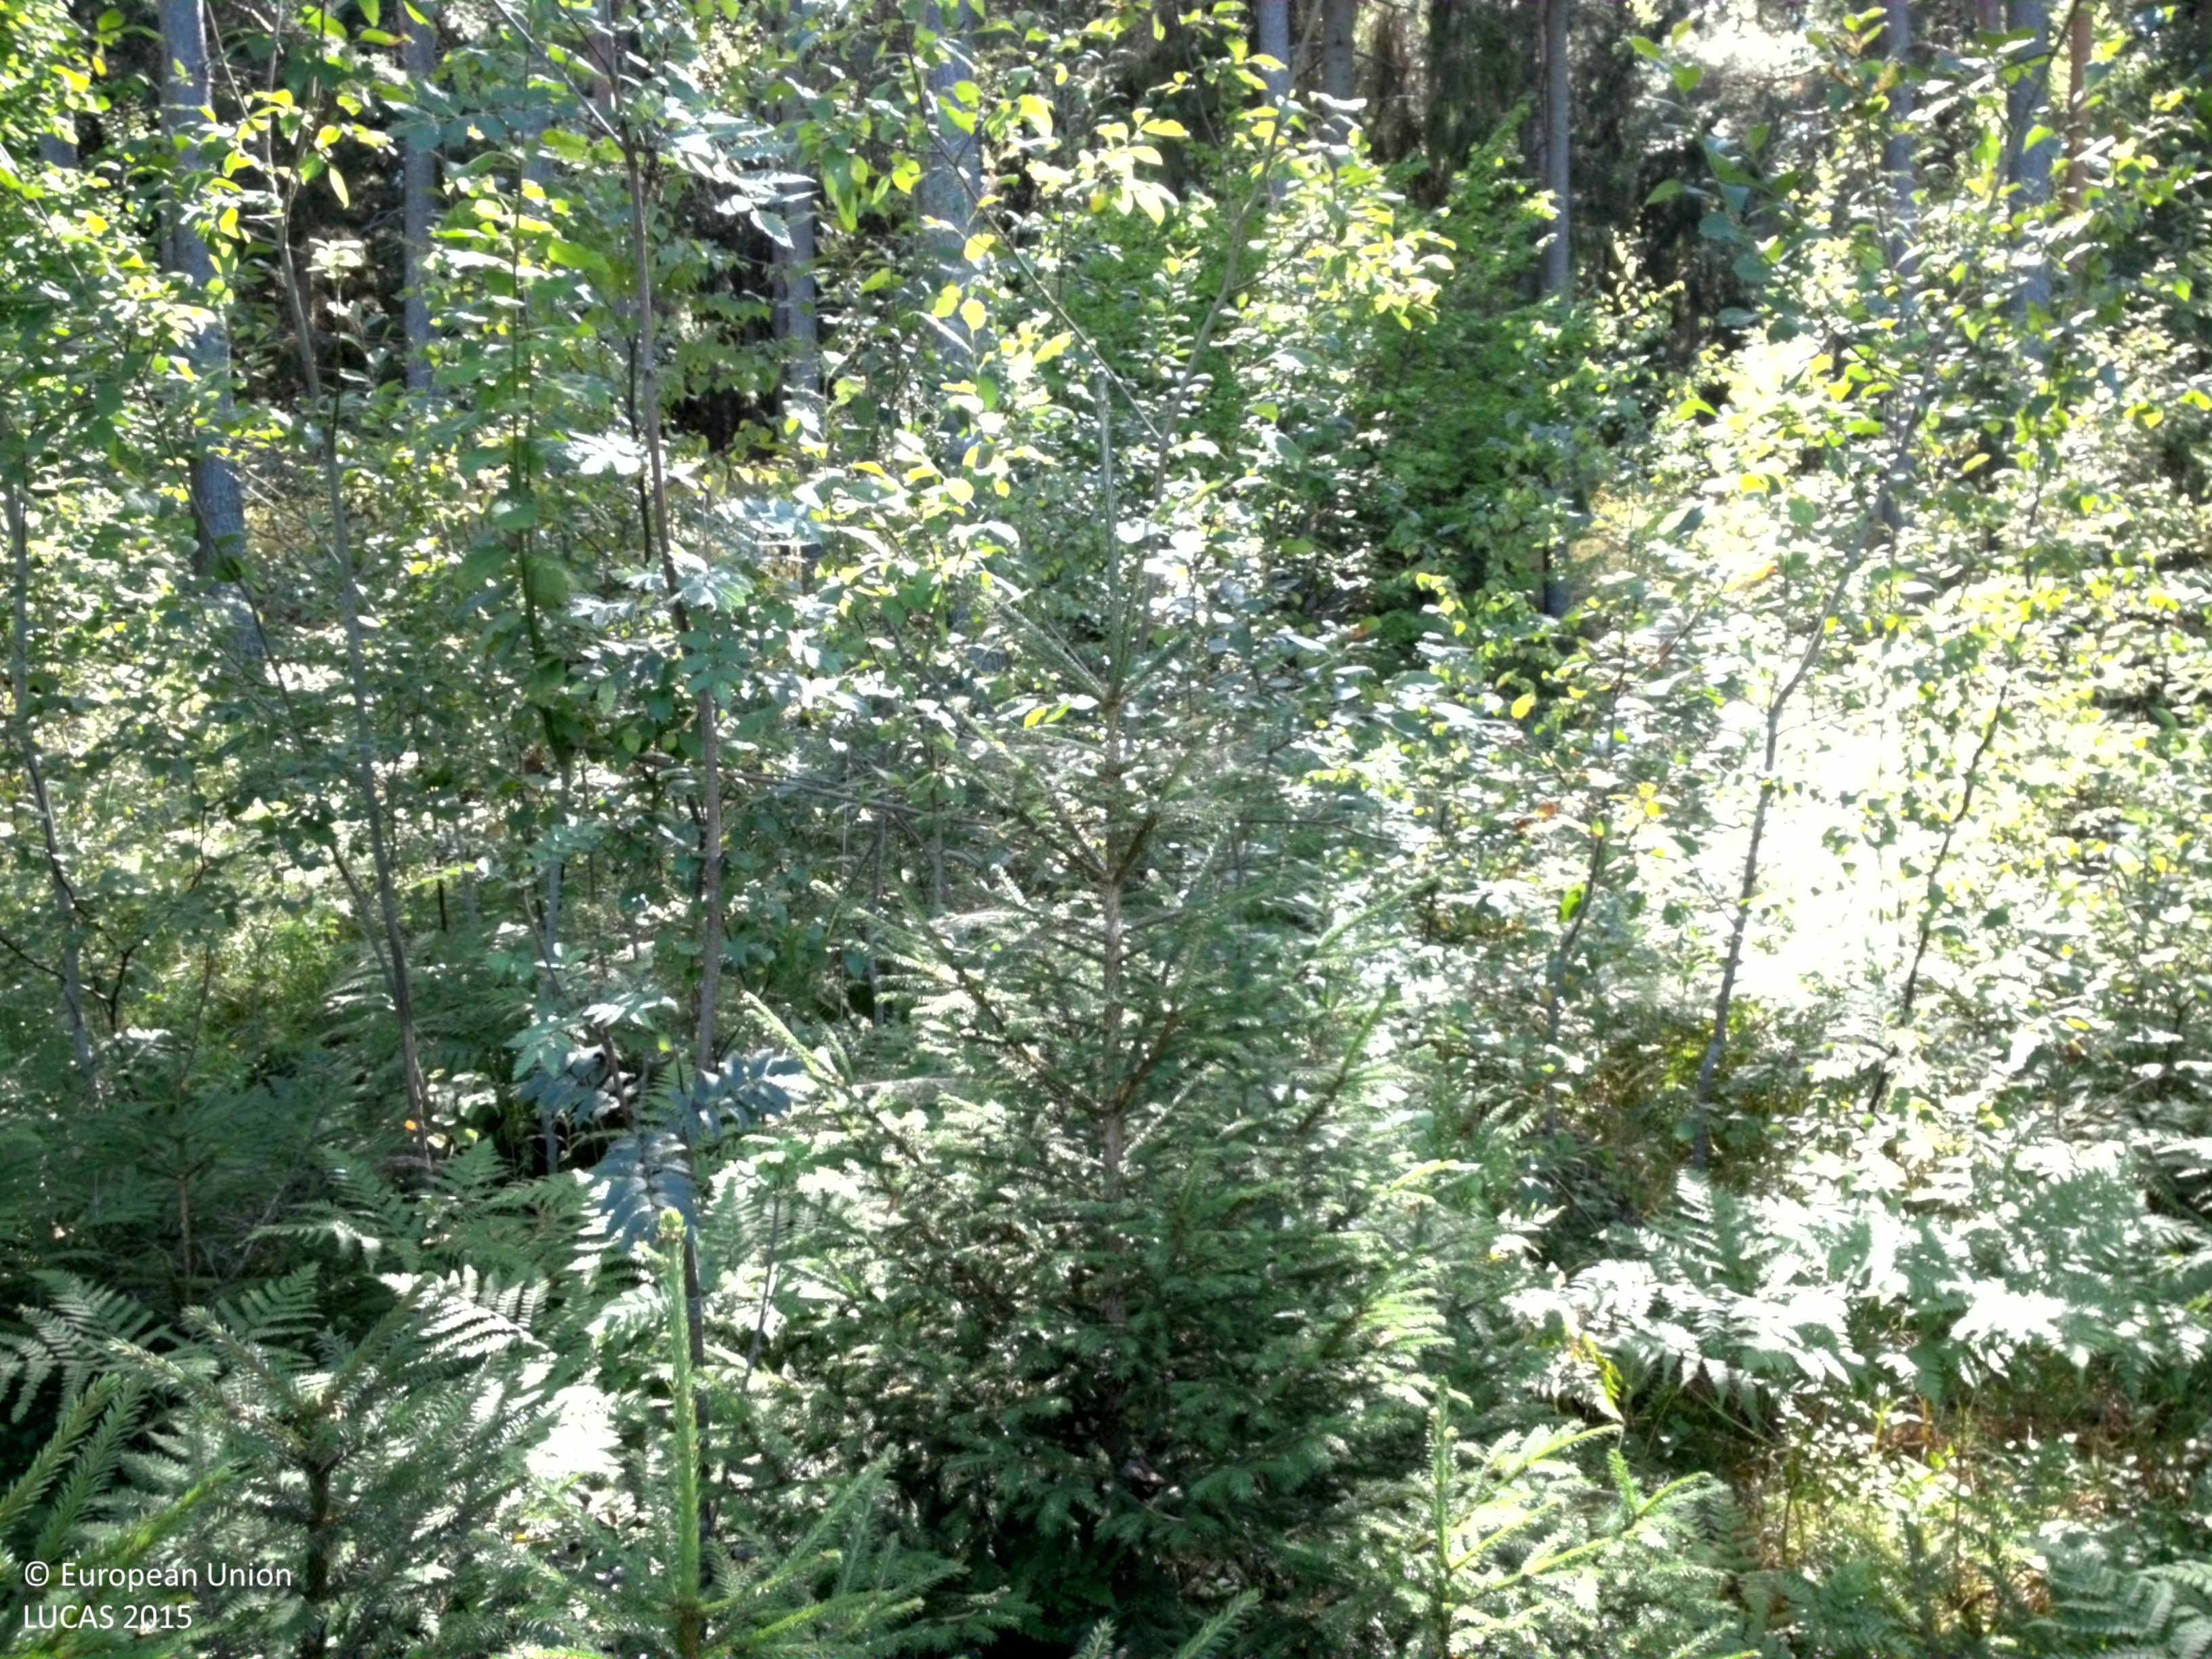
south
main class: Woodland
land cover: Pine dominated coniferous woodland
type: boreal forest
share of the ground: 50 - 75 %
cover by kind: coniferous forest trees 65 %, herbaceous plants 25 %, broadleaved forest trees 10 %
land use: Forestry
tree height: > 5 m
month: August
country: SE
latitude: 59.7070
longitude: 17.5483
